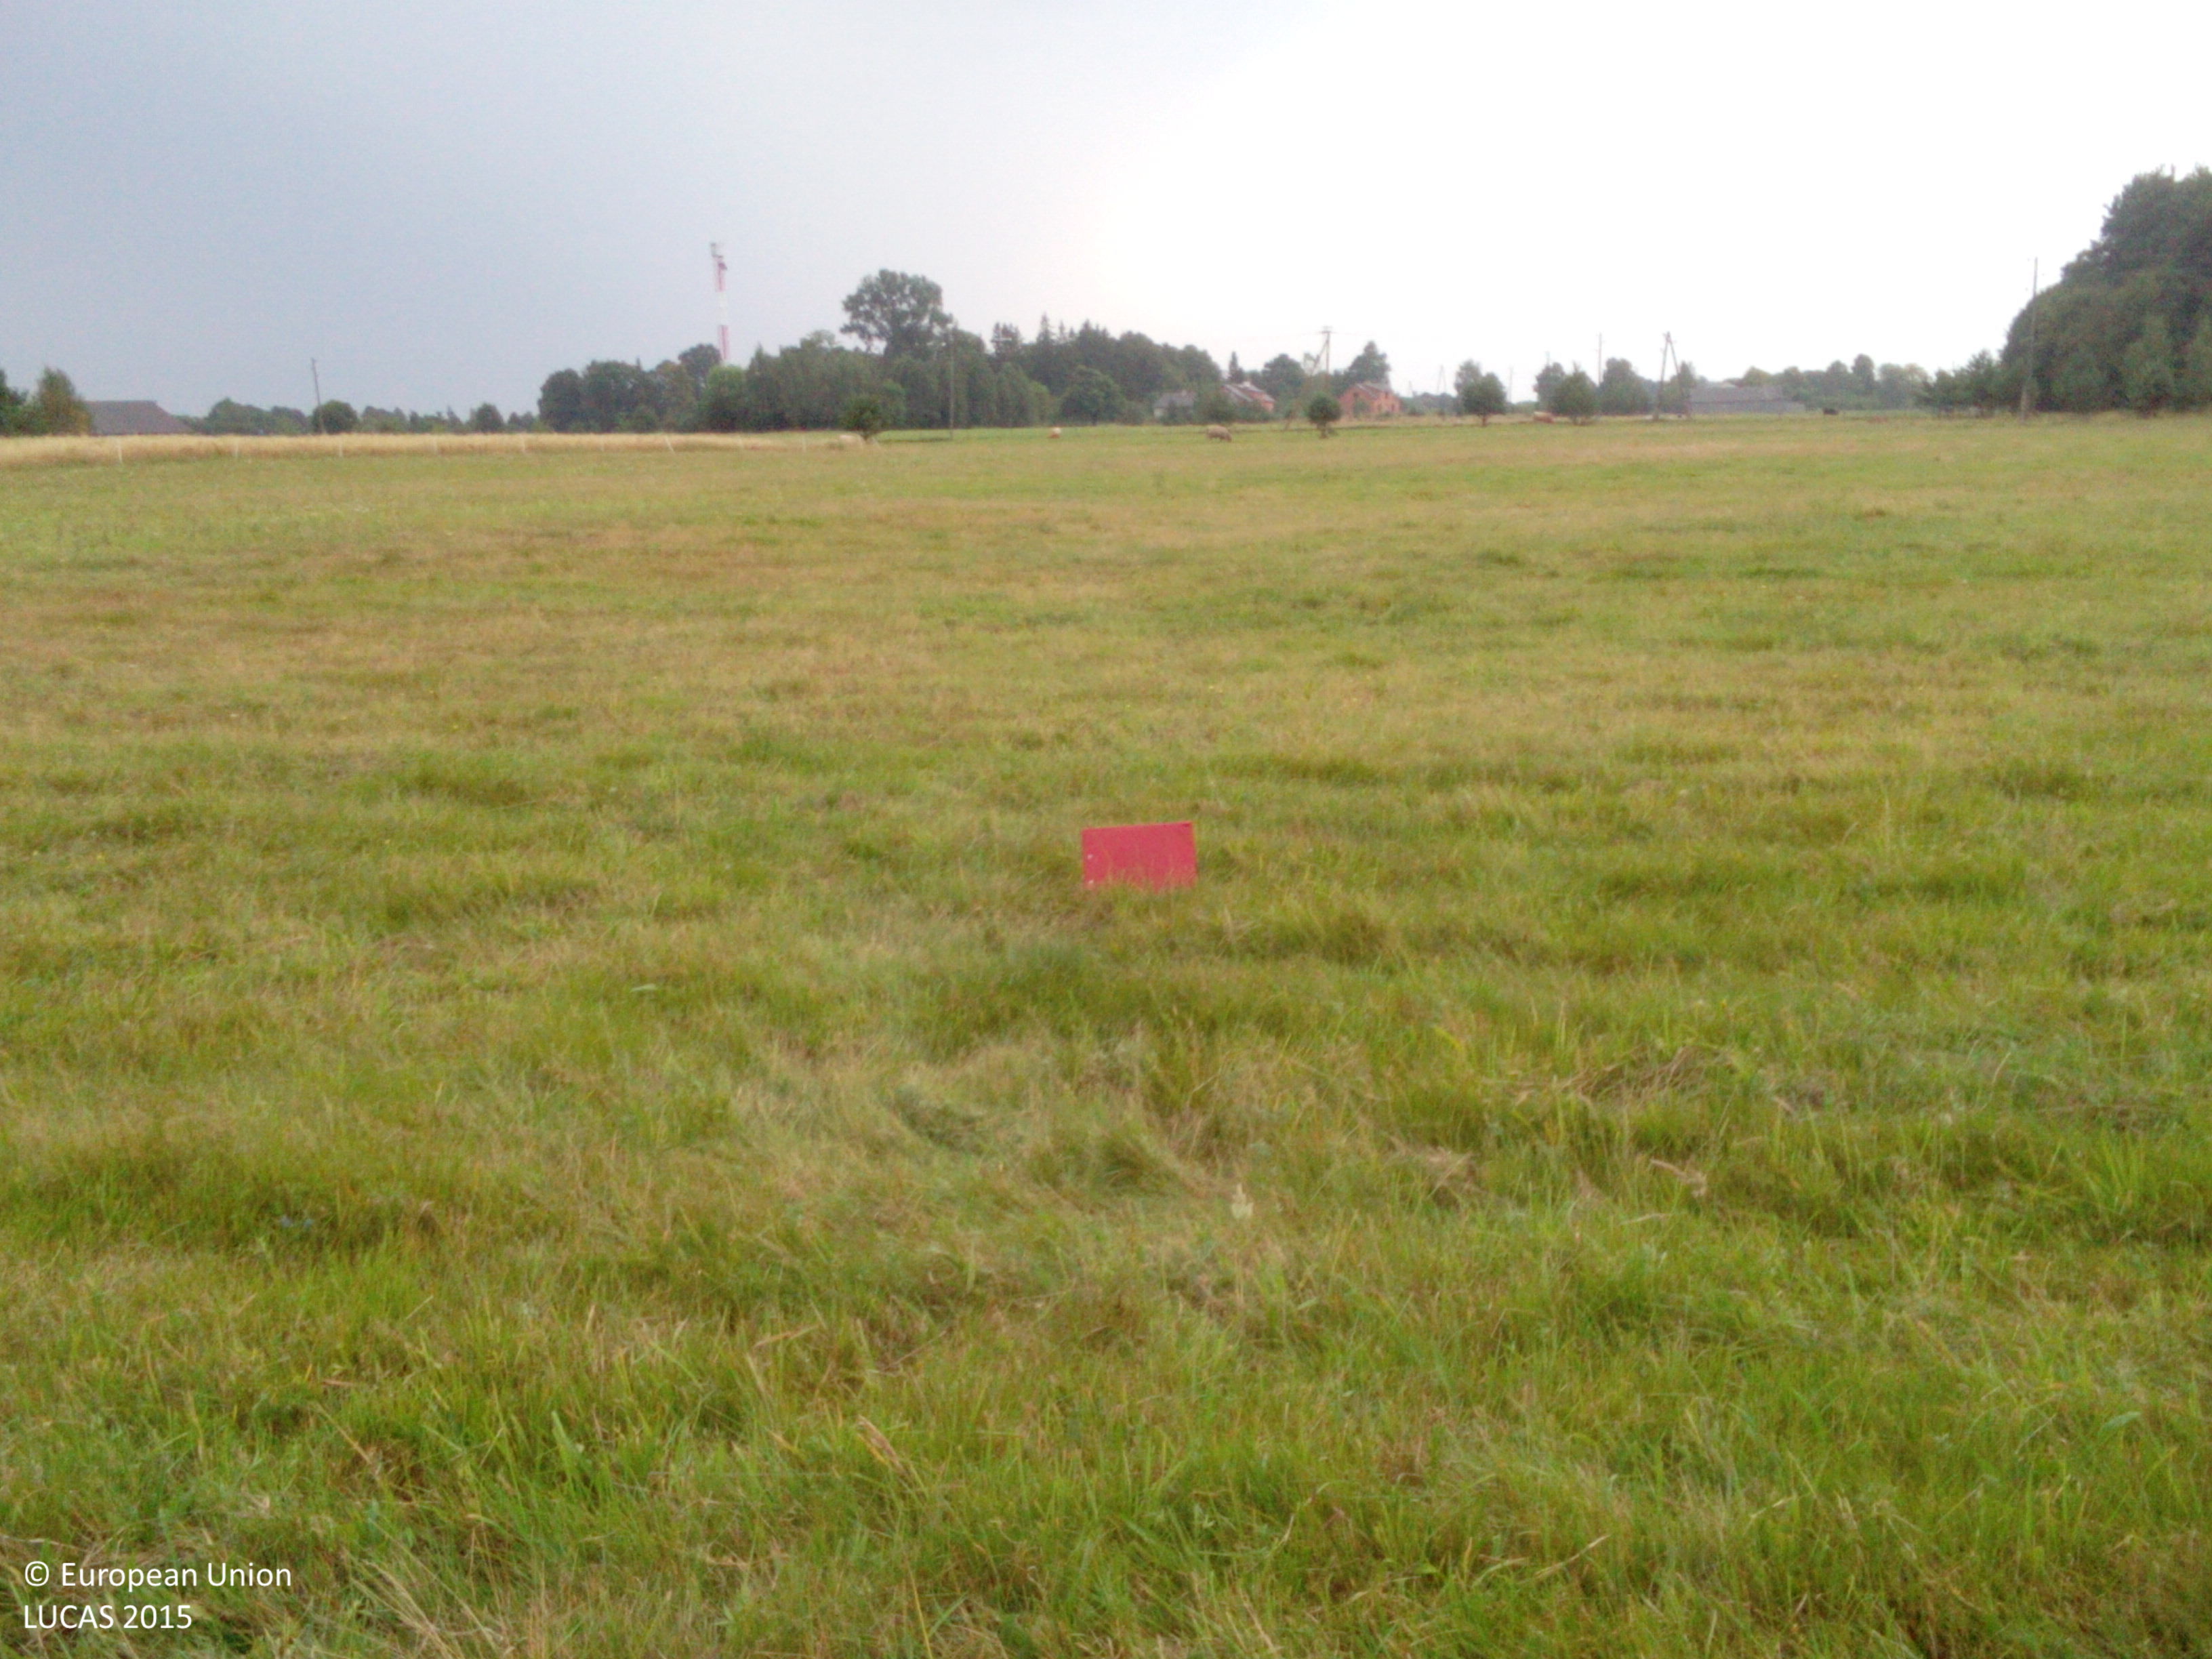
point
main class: Grassland
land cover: Grassland without tree/shrub cover
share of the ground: > 75 %
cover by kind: herbaceous plants 100 %
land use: Agriculture (excluding fallow land and kitchen gardens)
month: August
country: LV
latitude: 56.1710
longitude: 21.1683
